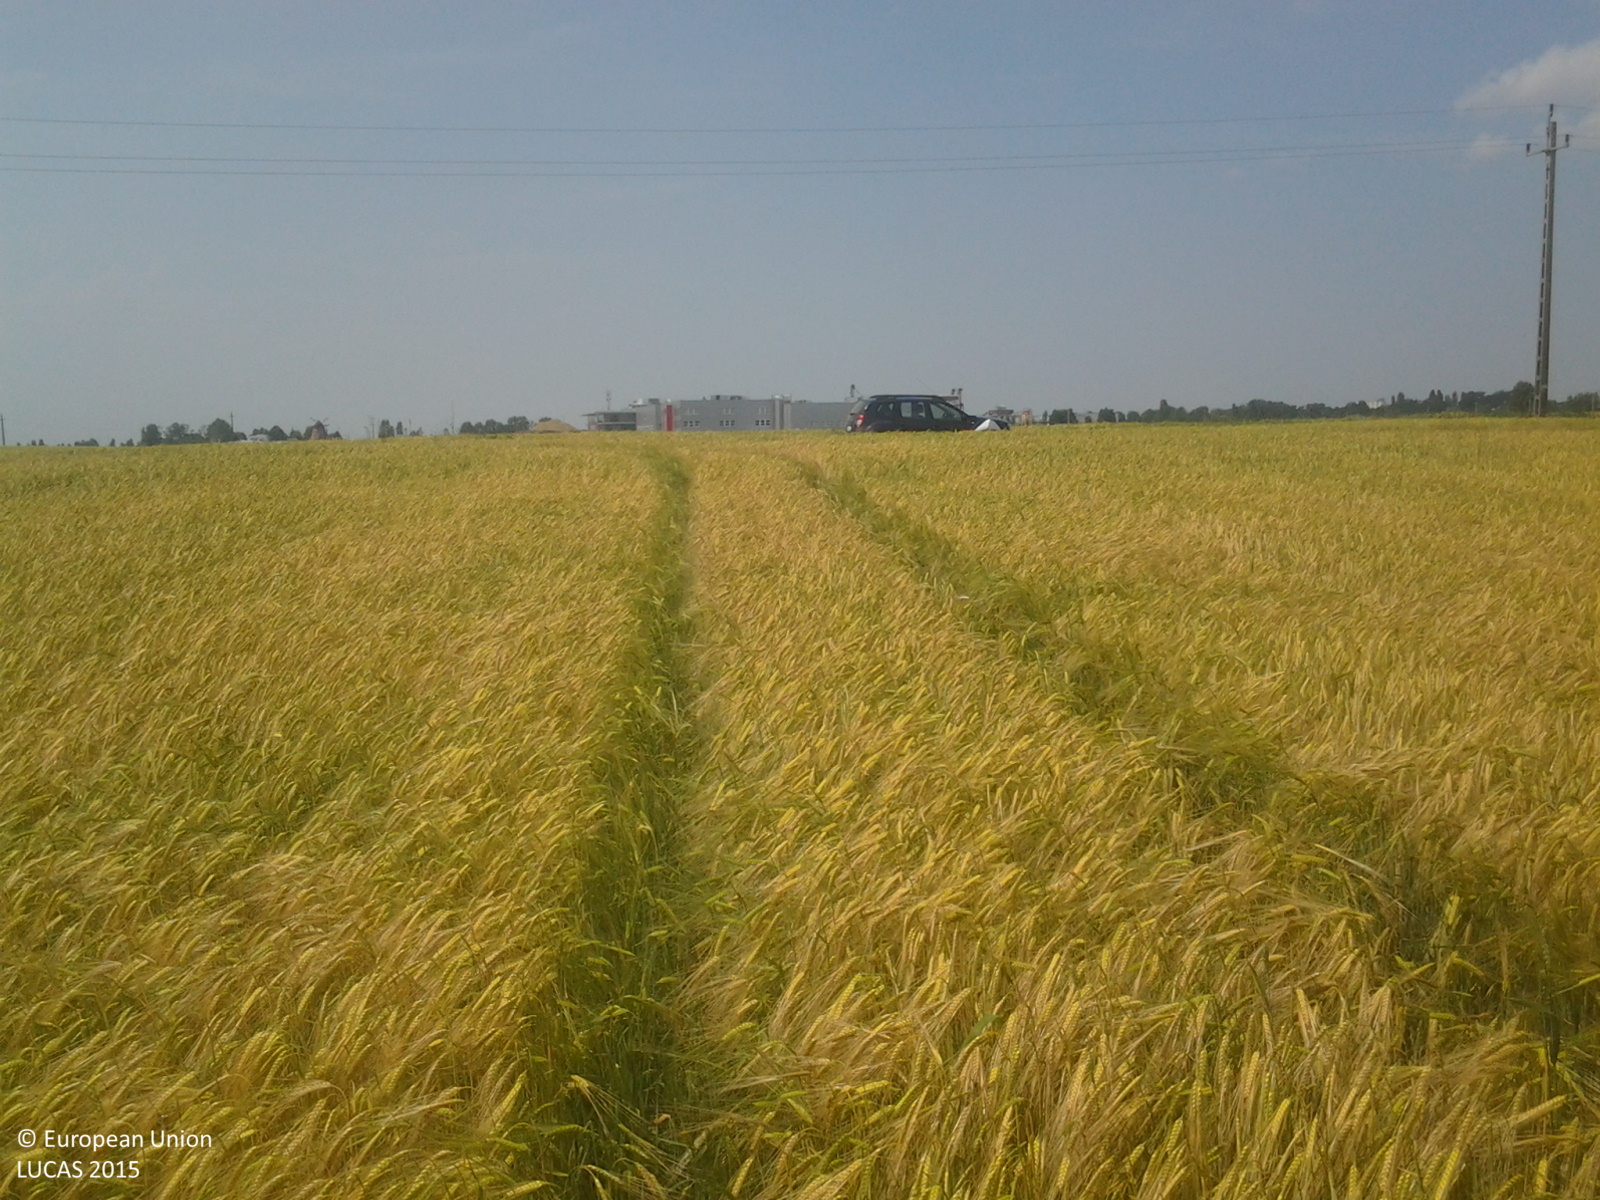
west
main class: Cropland
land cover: Barley
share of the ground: > 75 %
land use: Agriculture (excluding fallow land and kitchen gardens)
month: June
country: HU
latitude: 46.8868
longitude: 19.7192
